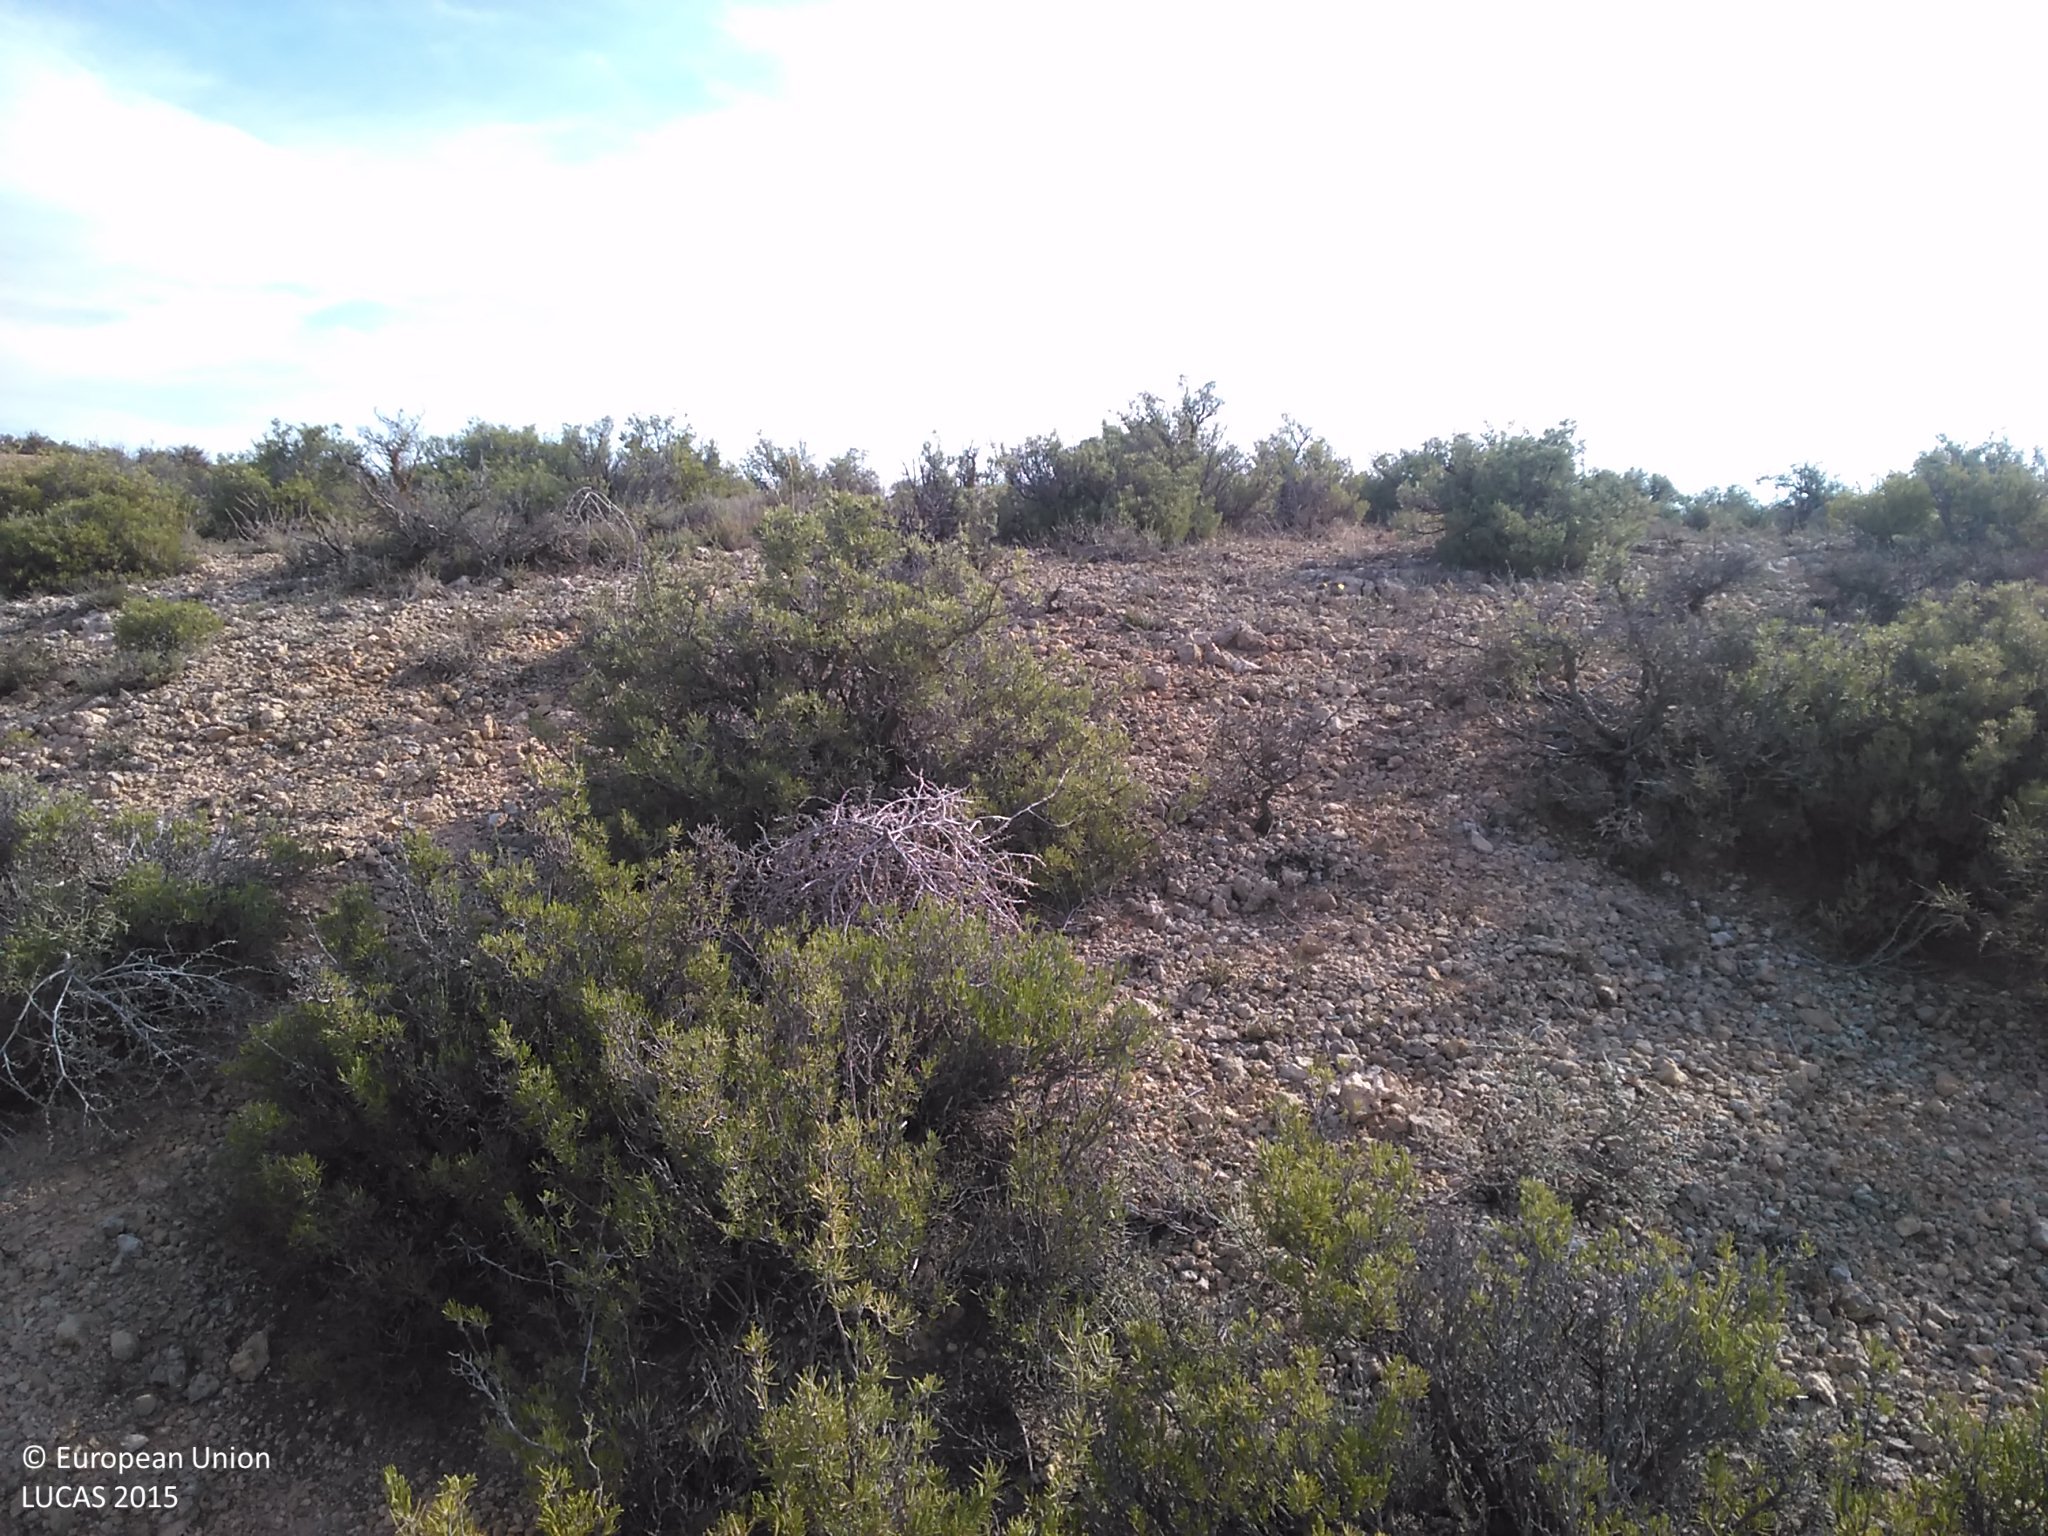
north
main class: Shrubland
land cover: Shrubland without tree cover
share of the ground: 25 - 50 %
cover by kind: unconsolidated bare surface 60 %, shrubs 40 %
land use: Semi-natural and natural areas not in use
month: July
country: ES
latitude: 41.2932
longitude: -2.1985
